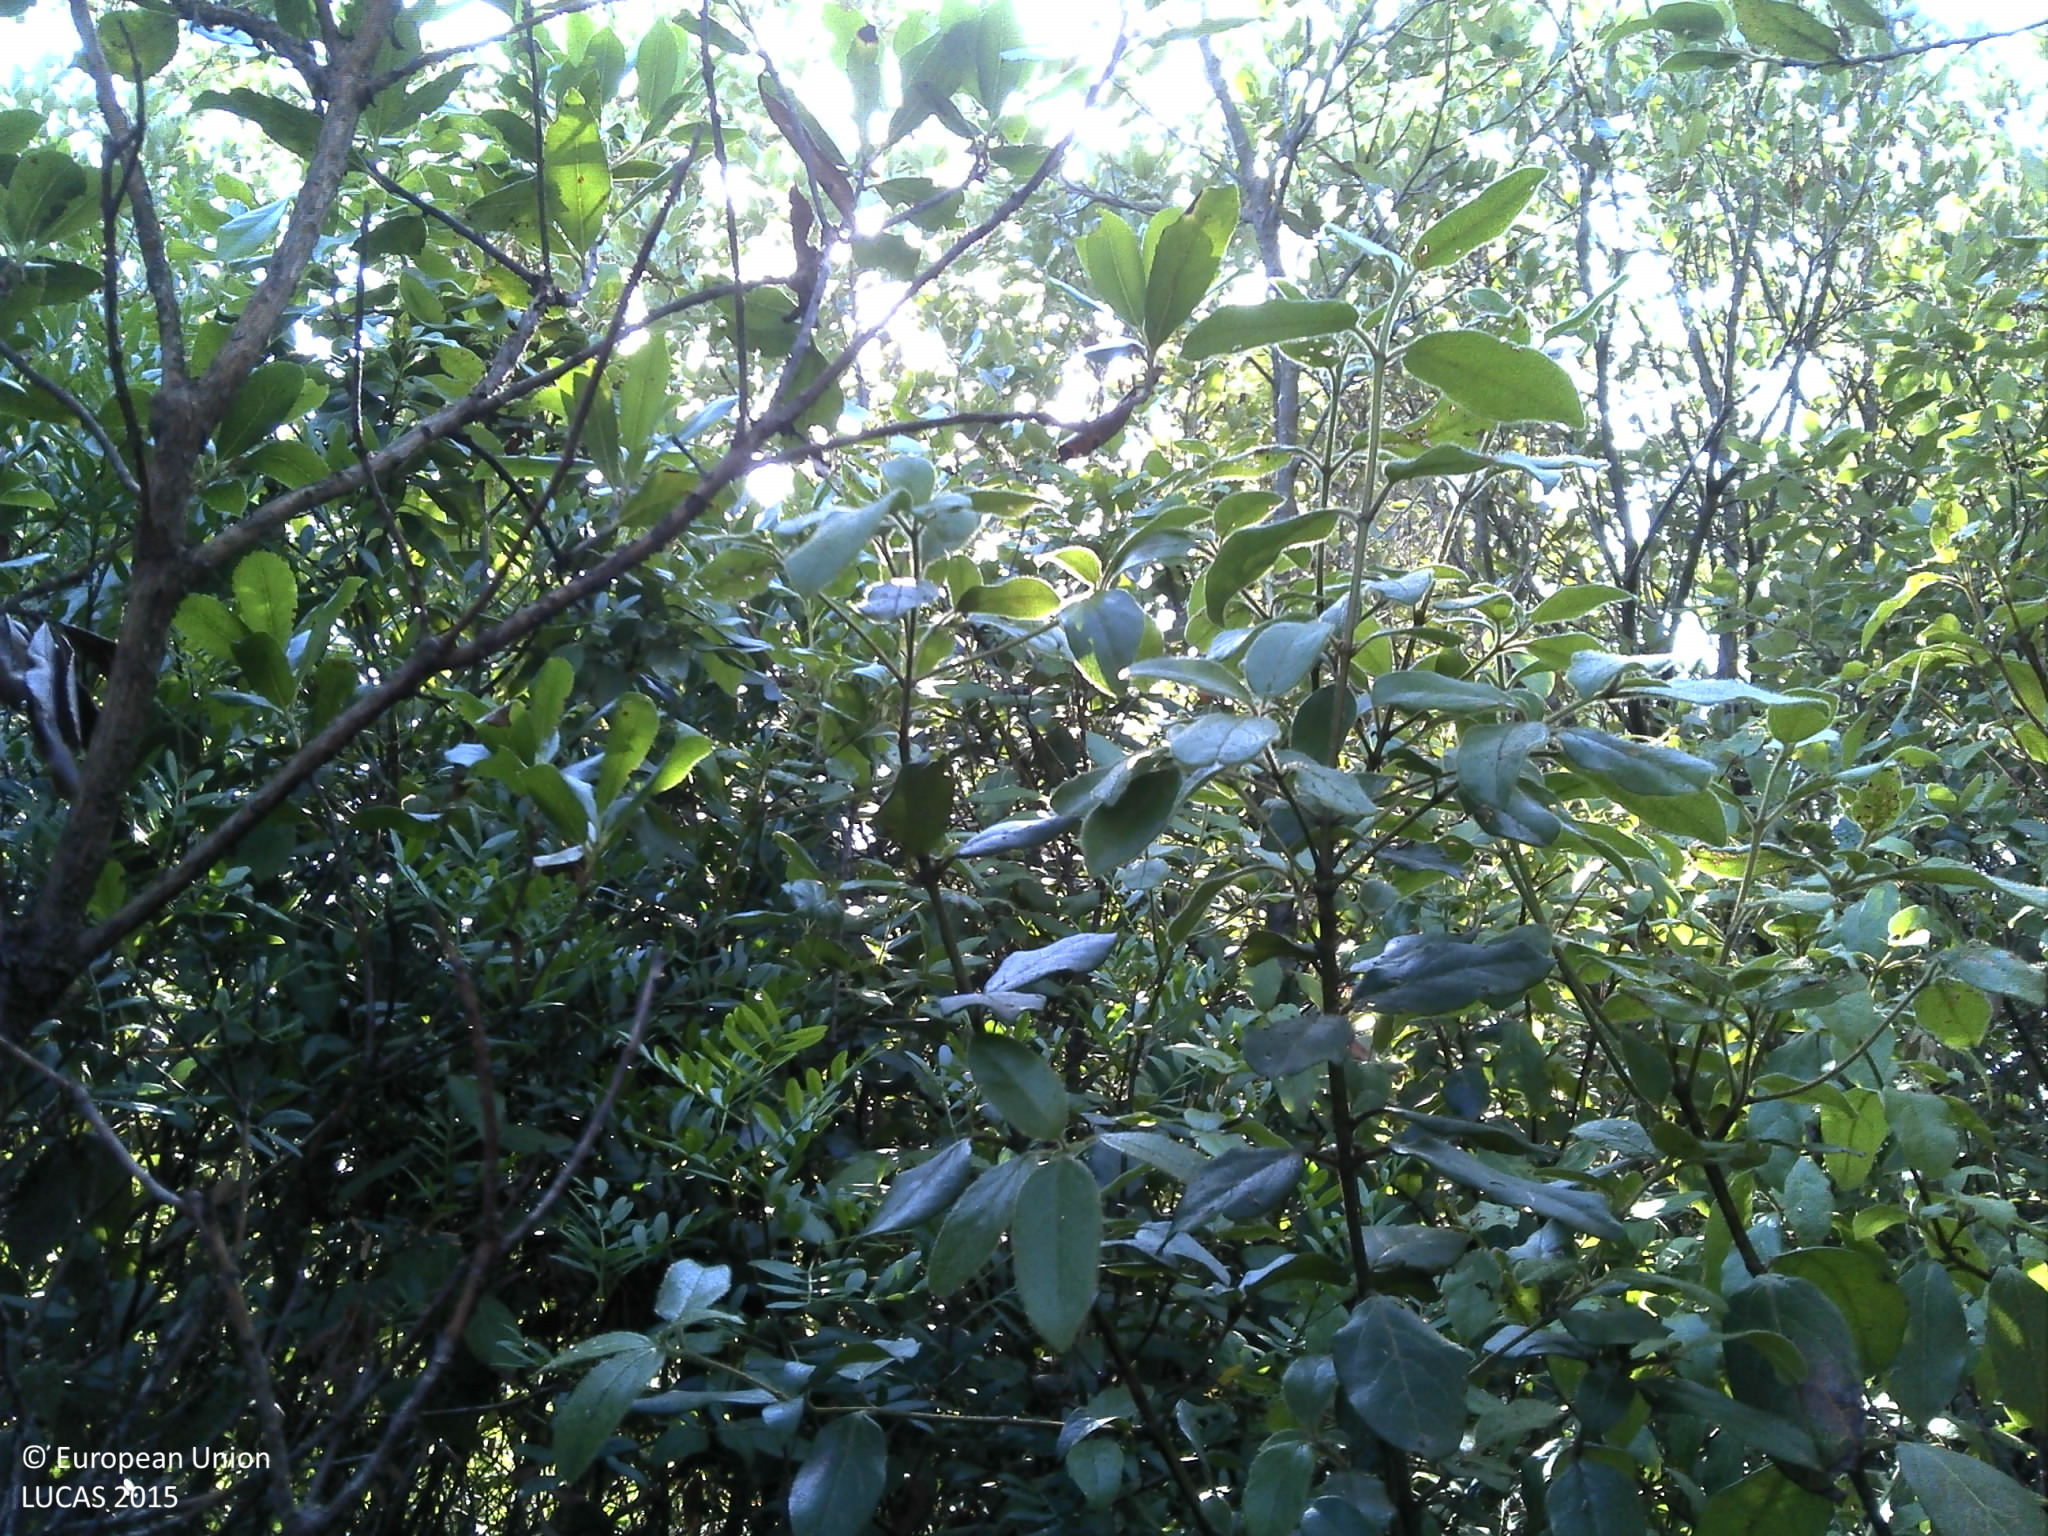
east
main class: Woodland
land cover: Other mixed woodland
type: coniferous forest of the mediterranean region
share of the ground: 25 - 50 %
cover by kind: shrubs 40 %, coniferous forest trees 30 %, broadleaved forest trees 20 %, unconsolidated bare surface 10 %
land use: Semi-natural and natural areas not in use
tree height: > 5 m
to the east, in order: Other mixed woodland; Tracks; Other mixed woodland; Rocks and stones; Other mixed woodland
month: August
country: HR
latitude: 42.9296
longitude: 17.1081
